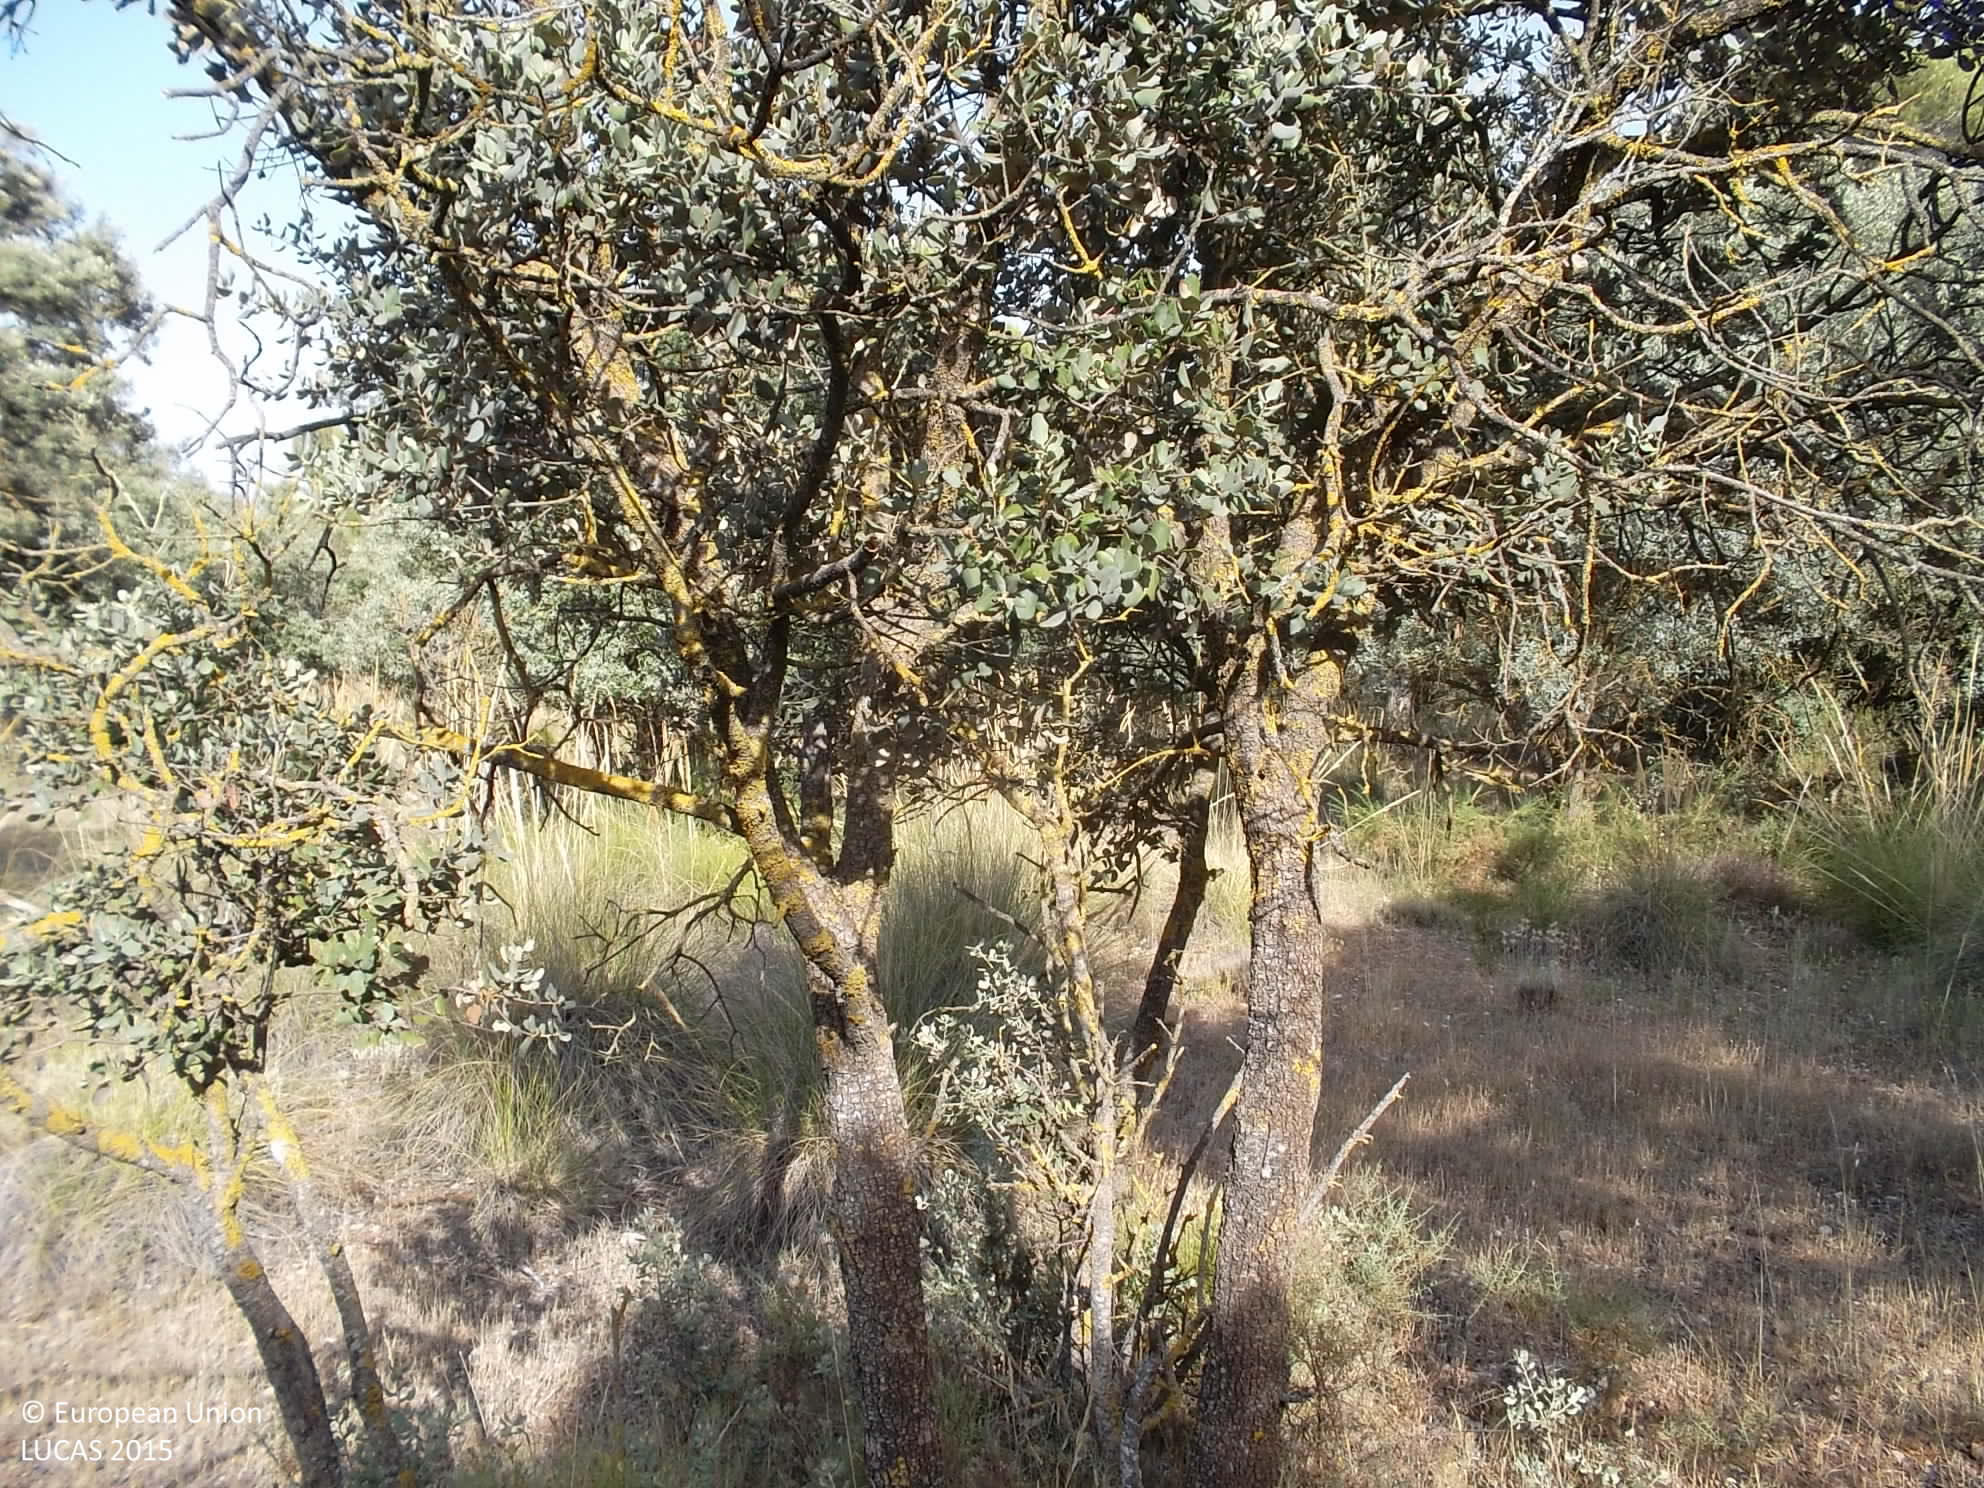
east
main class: Woodland
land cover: Broadleaved woodland
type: broadleaved evergreen forest
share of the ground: 50 - 75 %
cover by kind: broadleaved forest trees 40 %, shrubs 30 %, herbaceous plants 20 %, unconsolidated bare surface 10 %
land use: Semi-natural and natural areas not in use
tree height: > 5 m
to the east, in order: Broadleaved woodland; Pine dominated mixed woodland; Broadleaved woodland; Tracks; Nuts trees
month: June
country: ES
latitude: 37.6982
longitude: -2.8407
